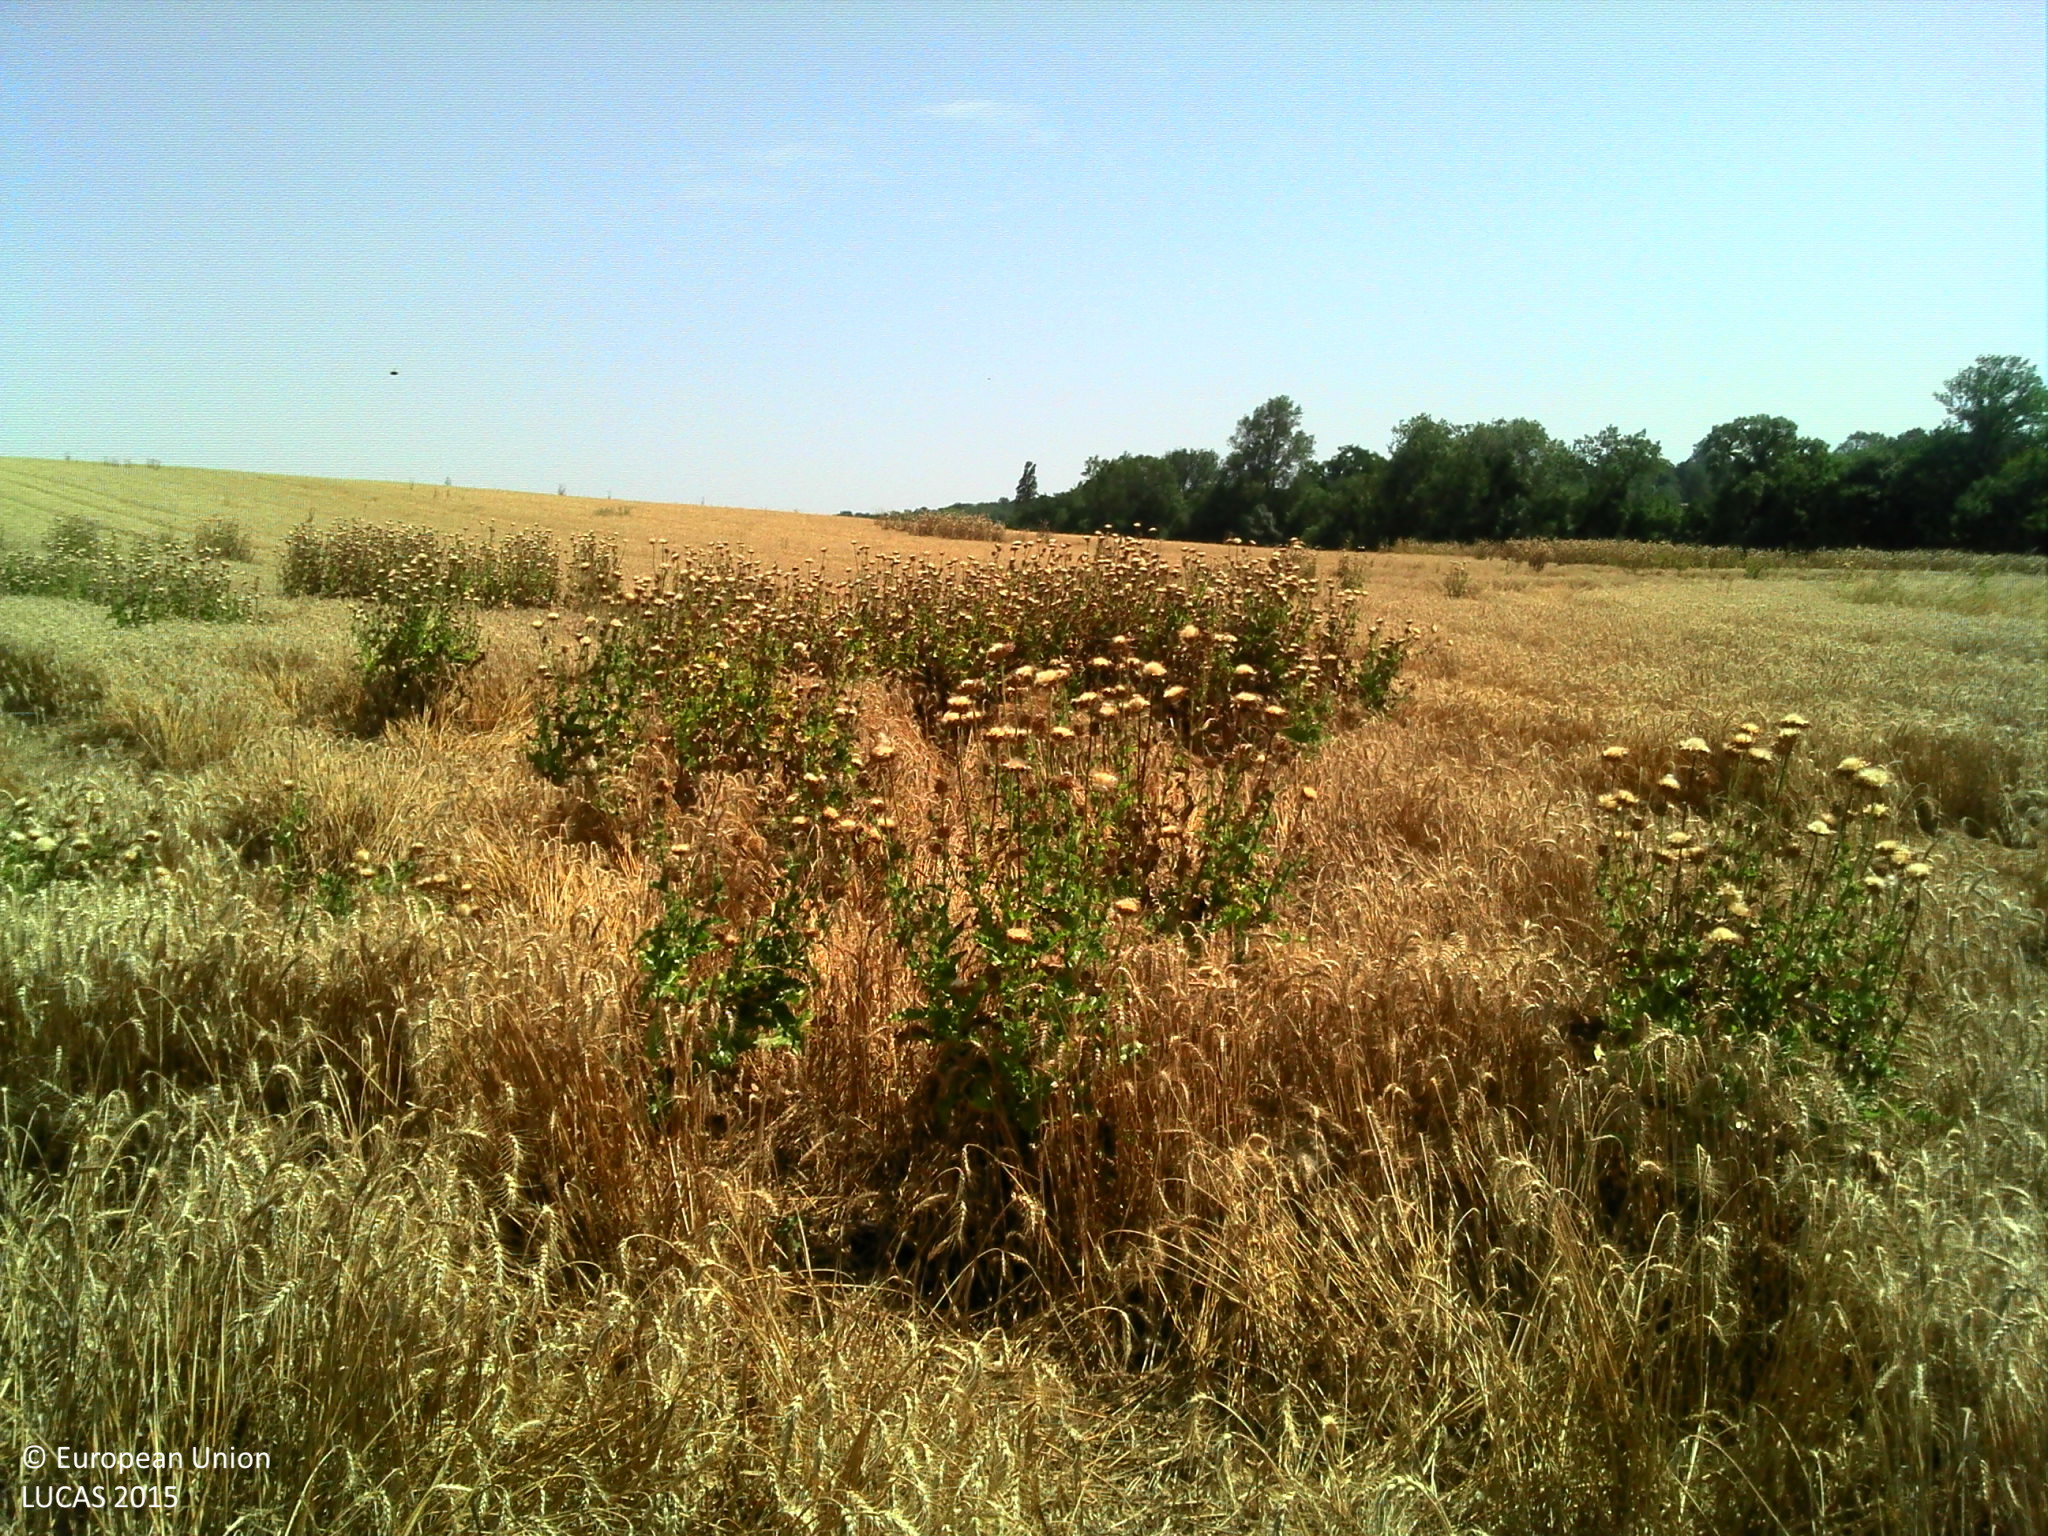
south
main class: Cropland
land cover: Common wheat
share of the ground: > 75 %
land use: Agriculture (excluding fallow land and kitchen gardens)
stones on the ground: < 10 %
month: July
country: FR
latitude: 43.5418
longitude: 1.0034
